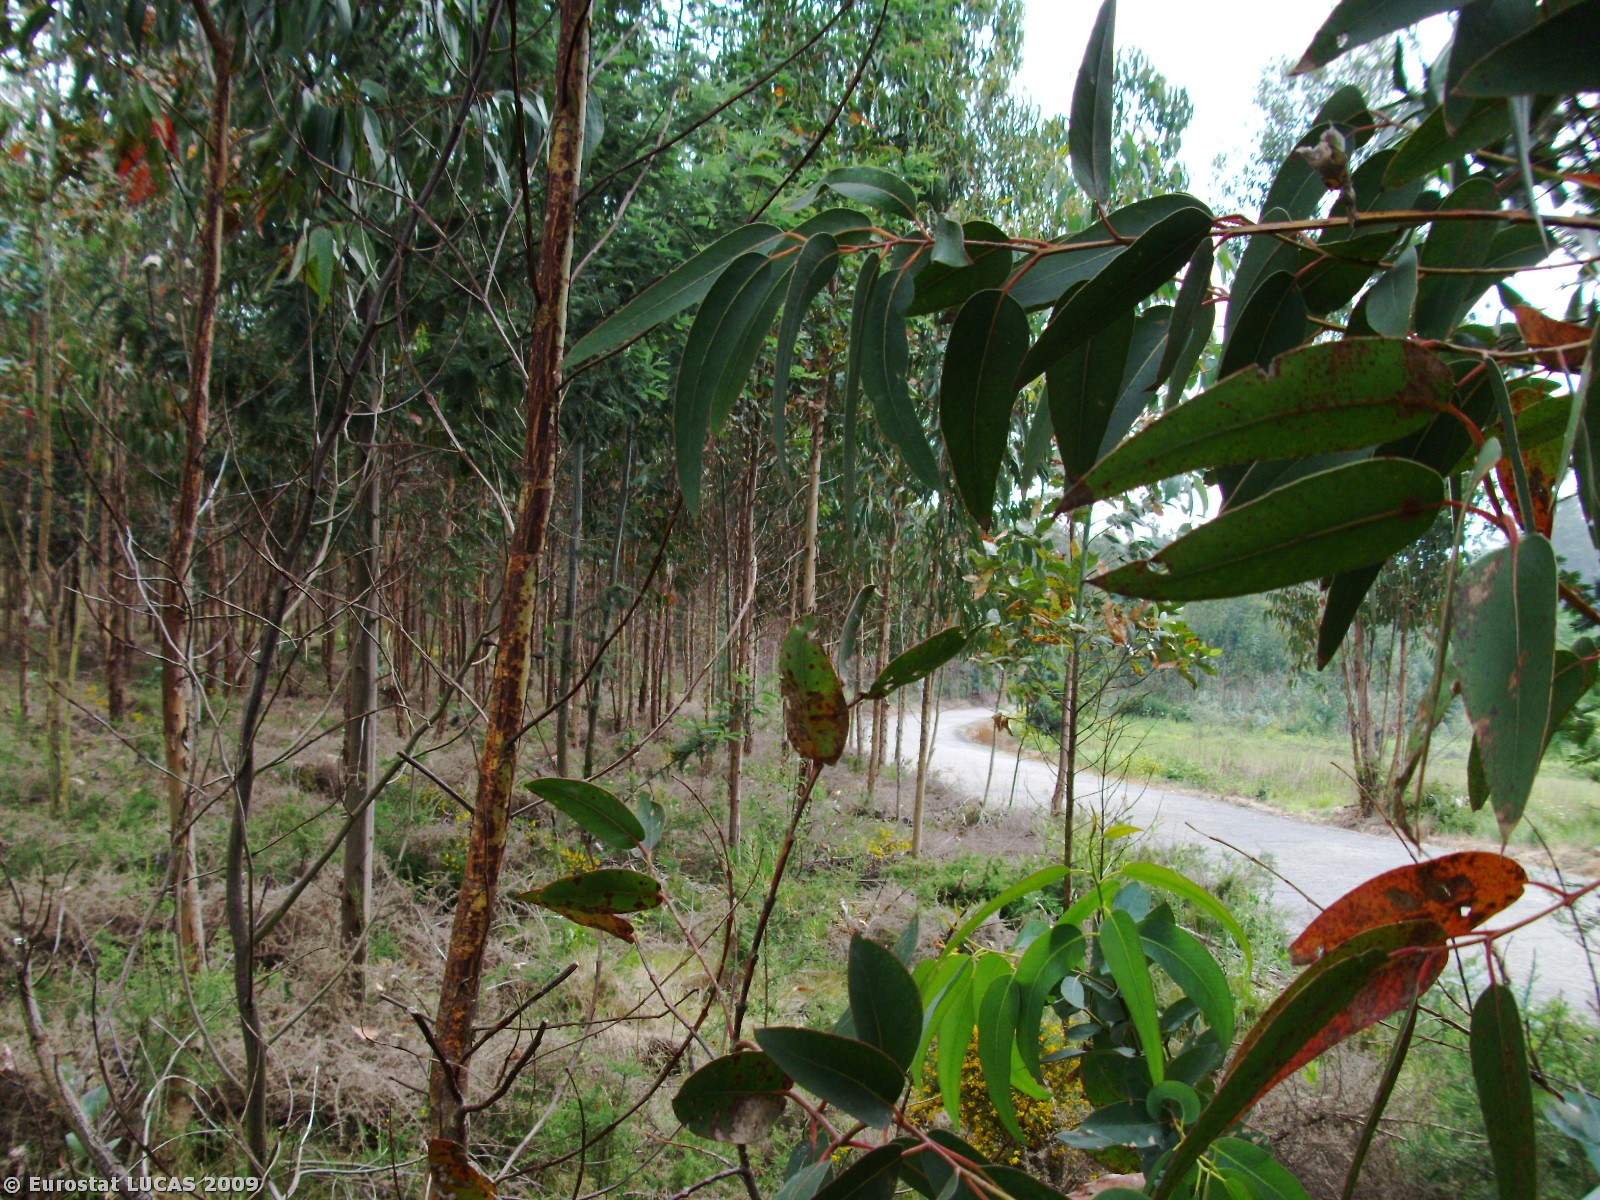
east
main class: Woodland
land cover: Broadleaved woodland
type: plantations and self-sown exotic forest
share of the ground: > 75 %
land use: Forestry
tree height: > 5 m
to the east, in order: Broadleaved woodland; Paved roads, cycling and walking lanes; Broadleaved woodland; Spontaneously vegetated surfaces; Shrubland with sparse tree cover; Spontaneously vegetated surfaces; Electric lines; Rye; Groves
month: May
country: PT
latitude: 40.5134
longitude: -8.3687
